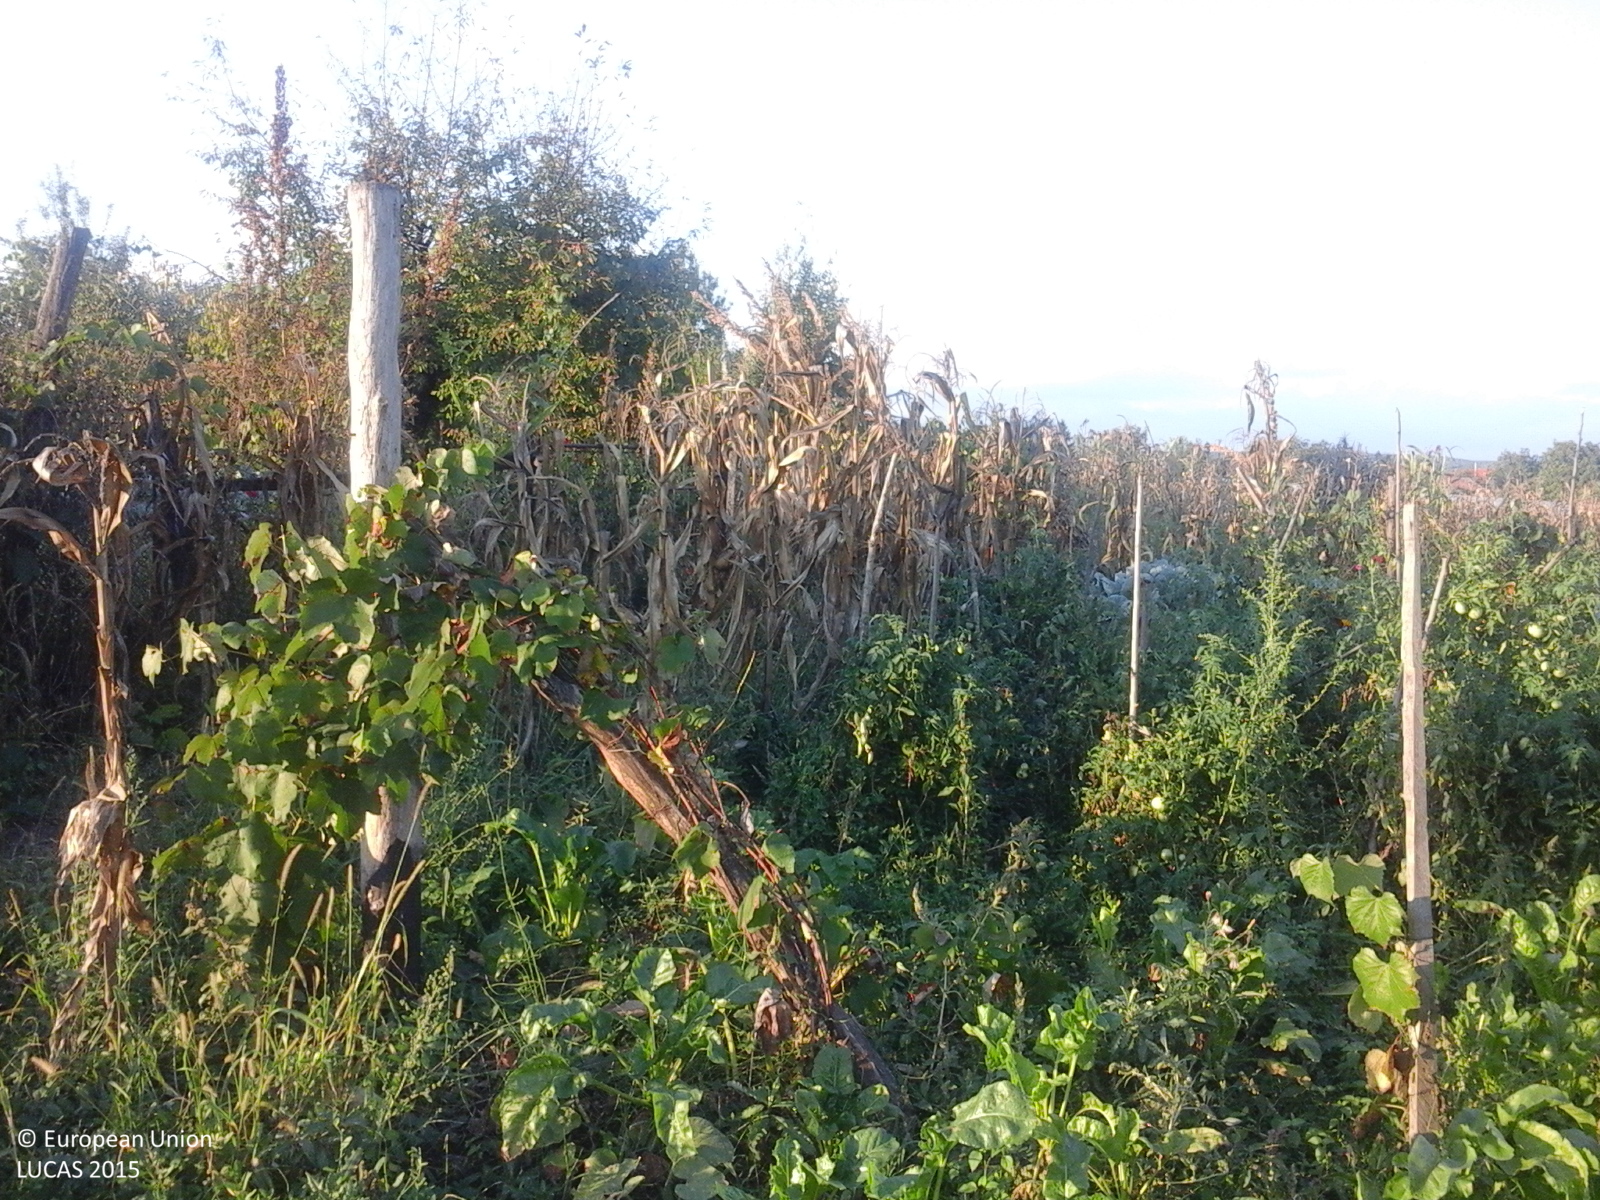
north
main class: Cropland
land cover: Lucerne
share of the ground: > 75 %
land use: Agriculture (excluding fallow land and kitchen gardens)
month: September
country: RO
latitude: 45.0213
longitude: 23.6000
